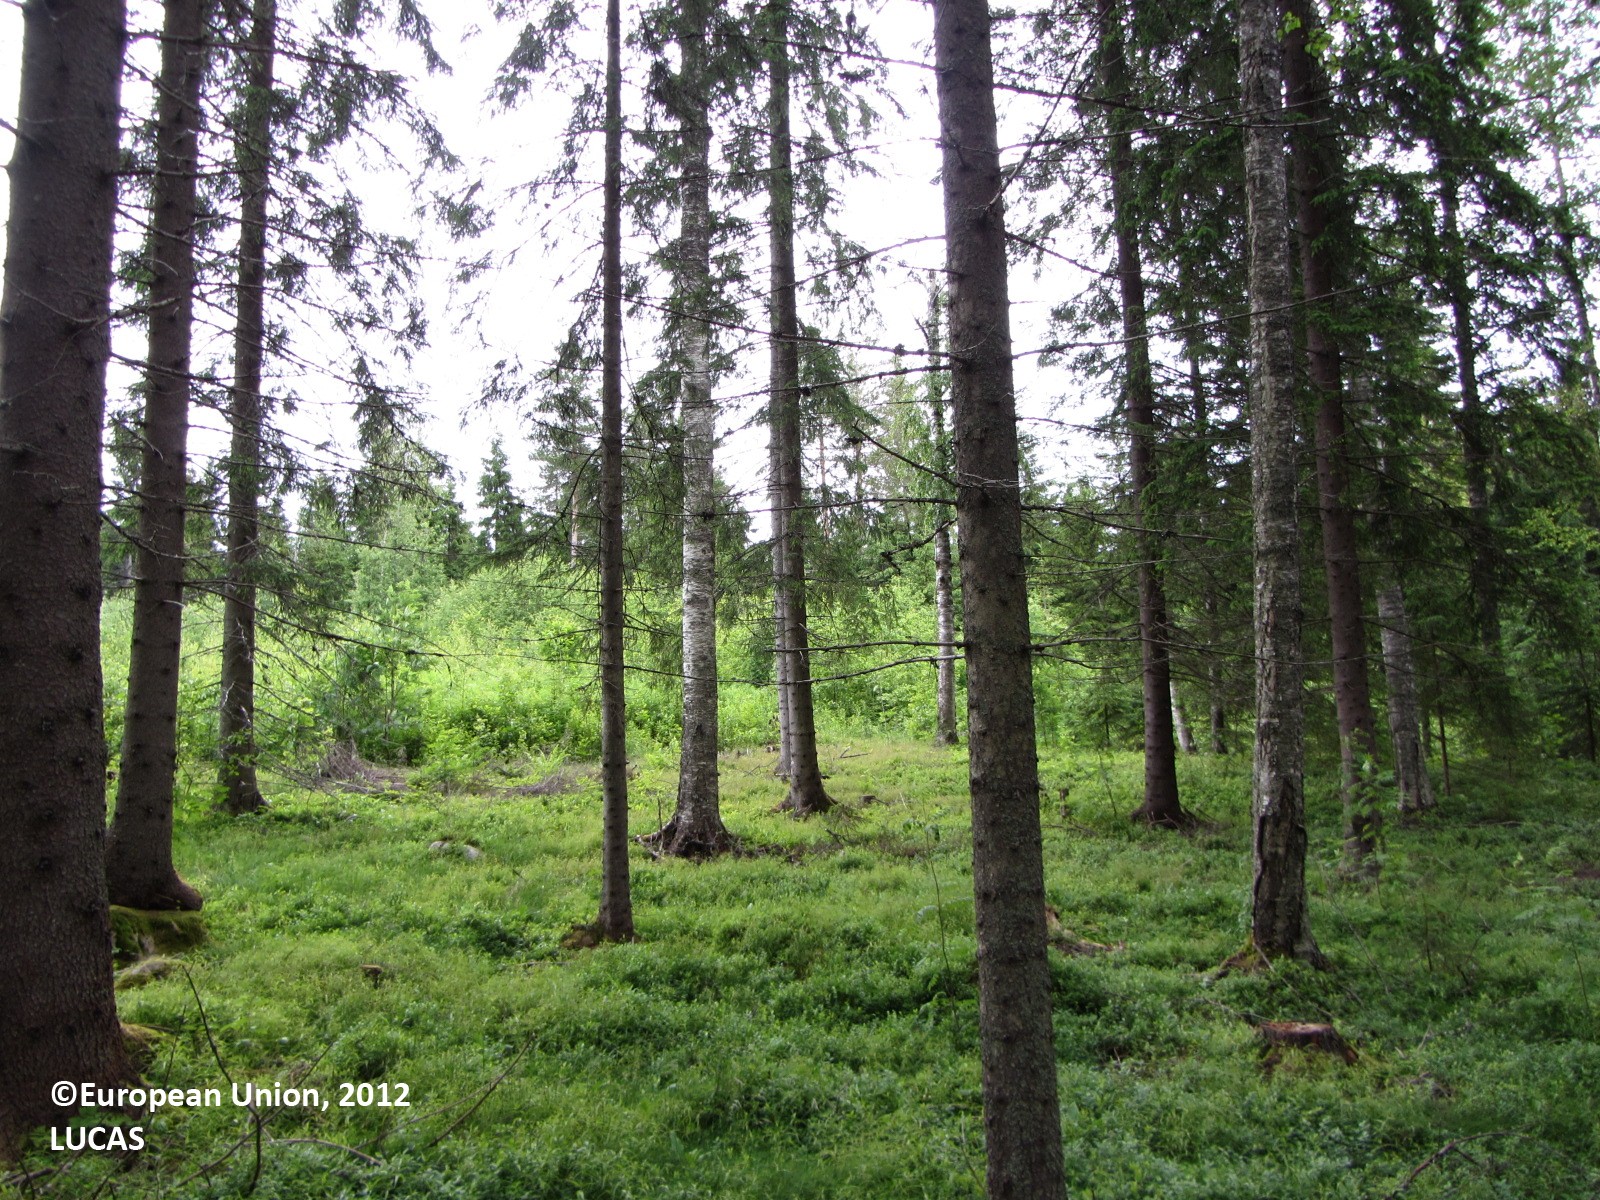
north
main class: Woodland
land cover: Spruce dominated mixed woodland
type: boreal forest
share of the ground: 50 - 75 %
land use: Forestry
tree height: > 5 m
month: June
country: FI
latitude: 62.5940
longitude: 25.5150
